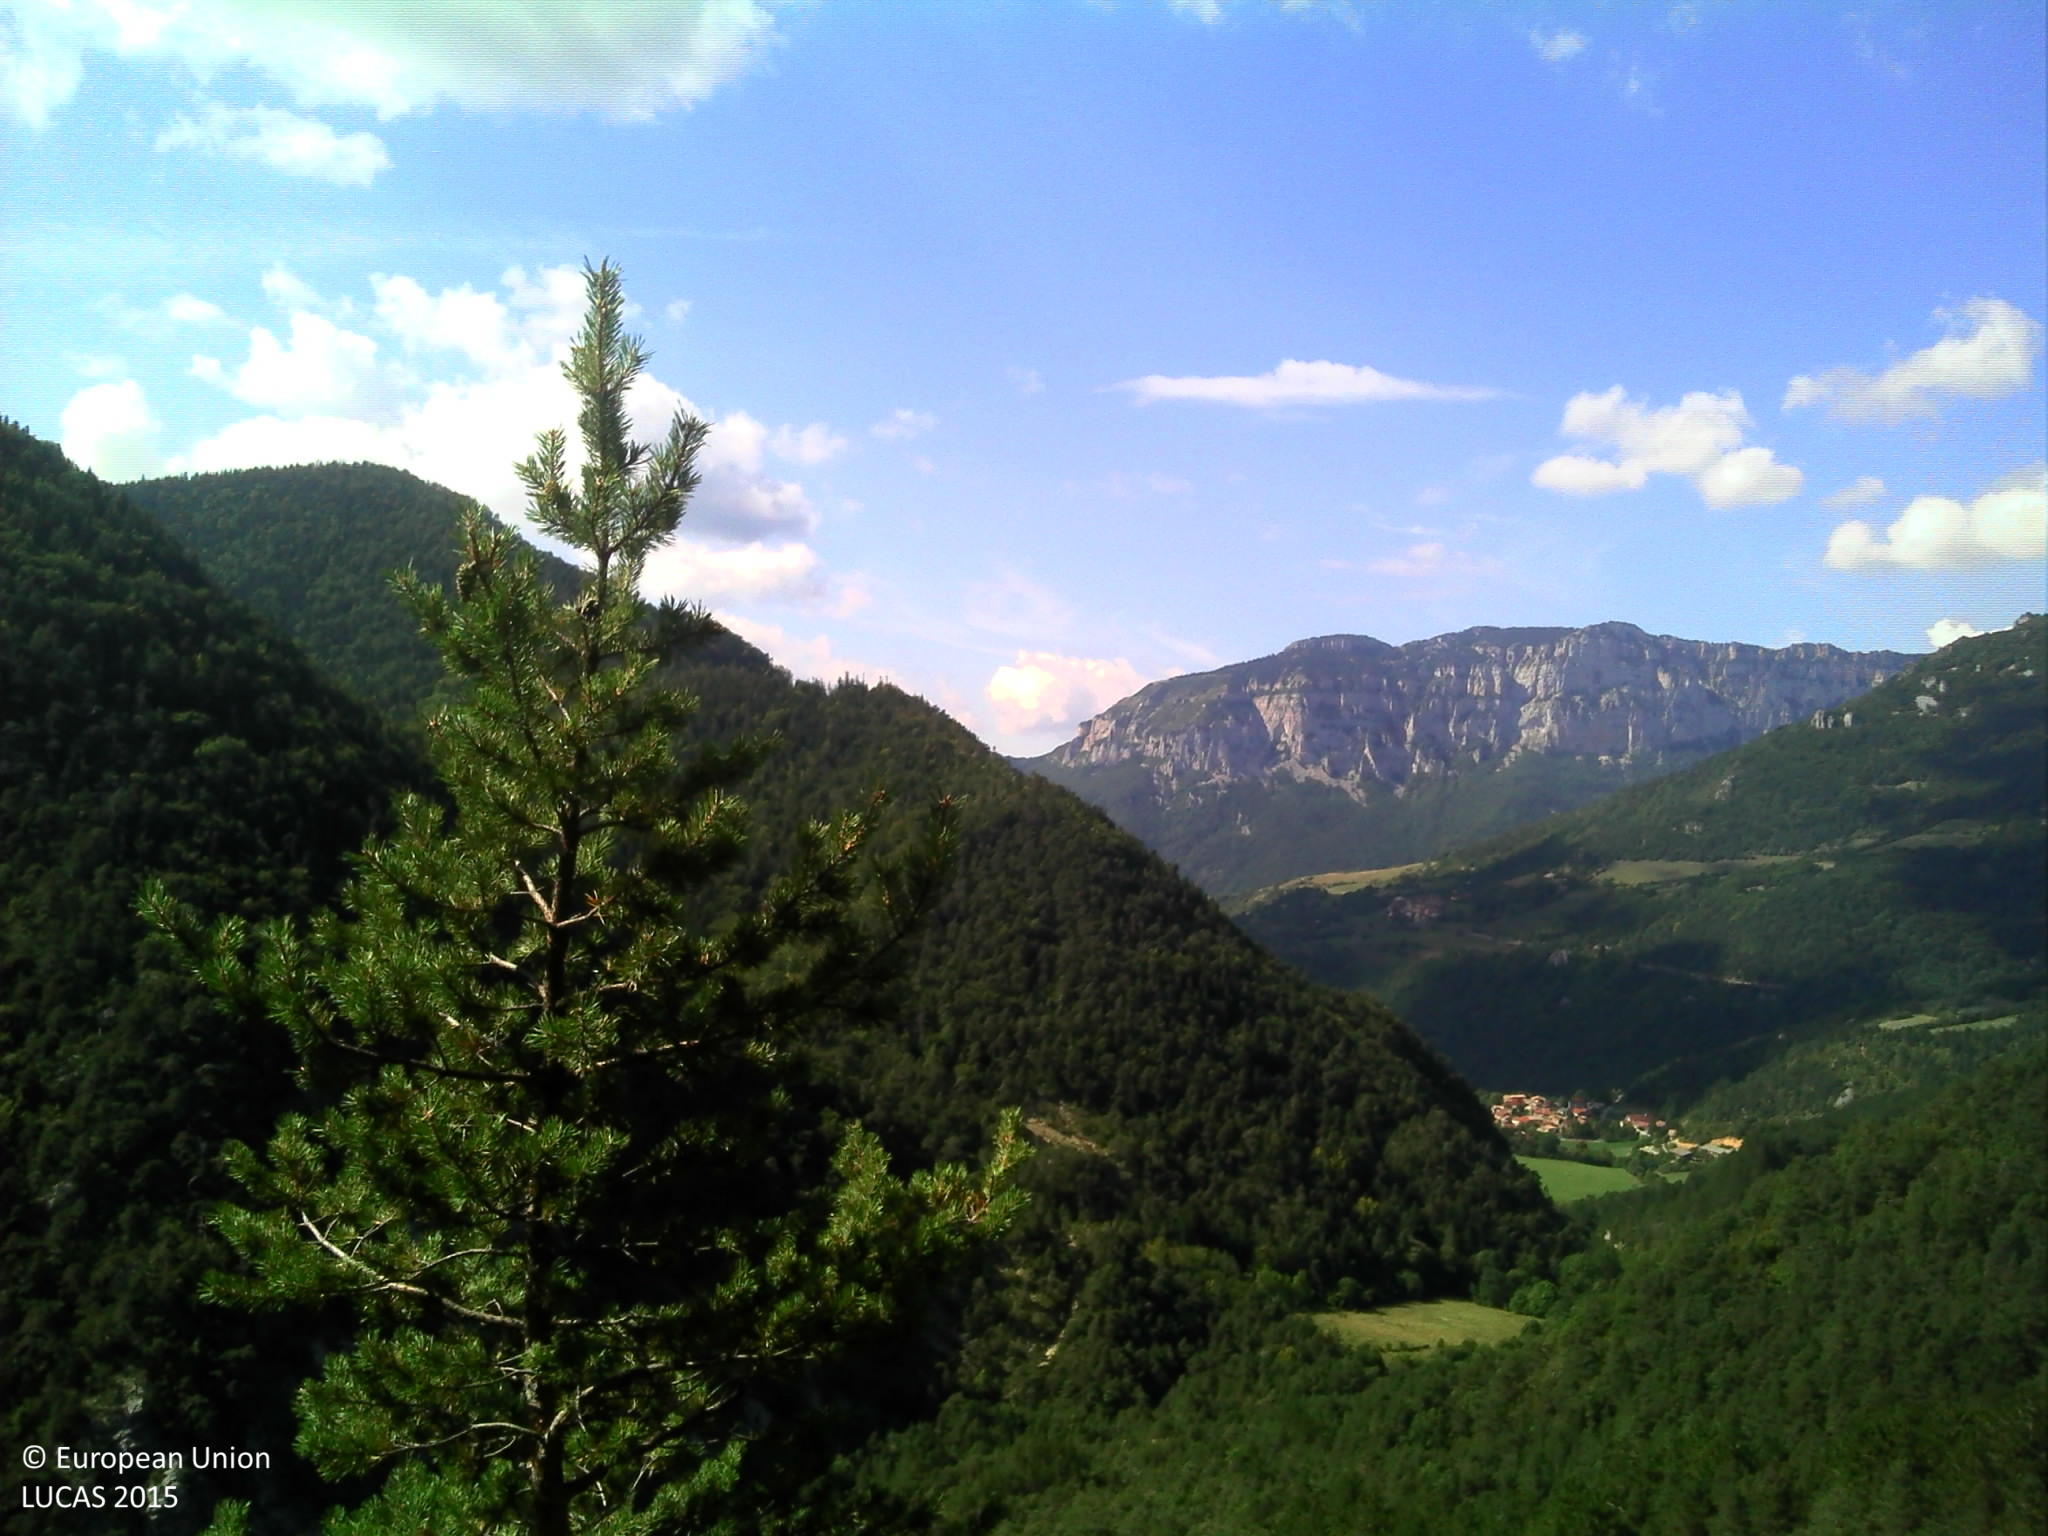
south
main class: Woodland
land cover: Pine dominated coniferous woodland
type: hemiboreal forest and nemoral coniferous forest and mixed broadleaved-coniferous forest
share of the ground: > 75 %
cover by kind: coniferous forest trees 95 %, herbaceous plants 5 %
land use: Semi-natural and natural areas not in use
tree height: > 5 m
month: September
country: FR
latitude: 44.7437
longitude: 5.5734
